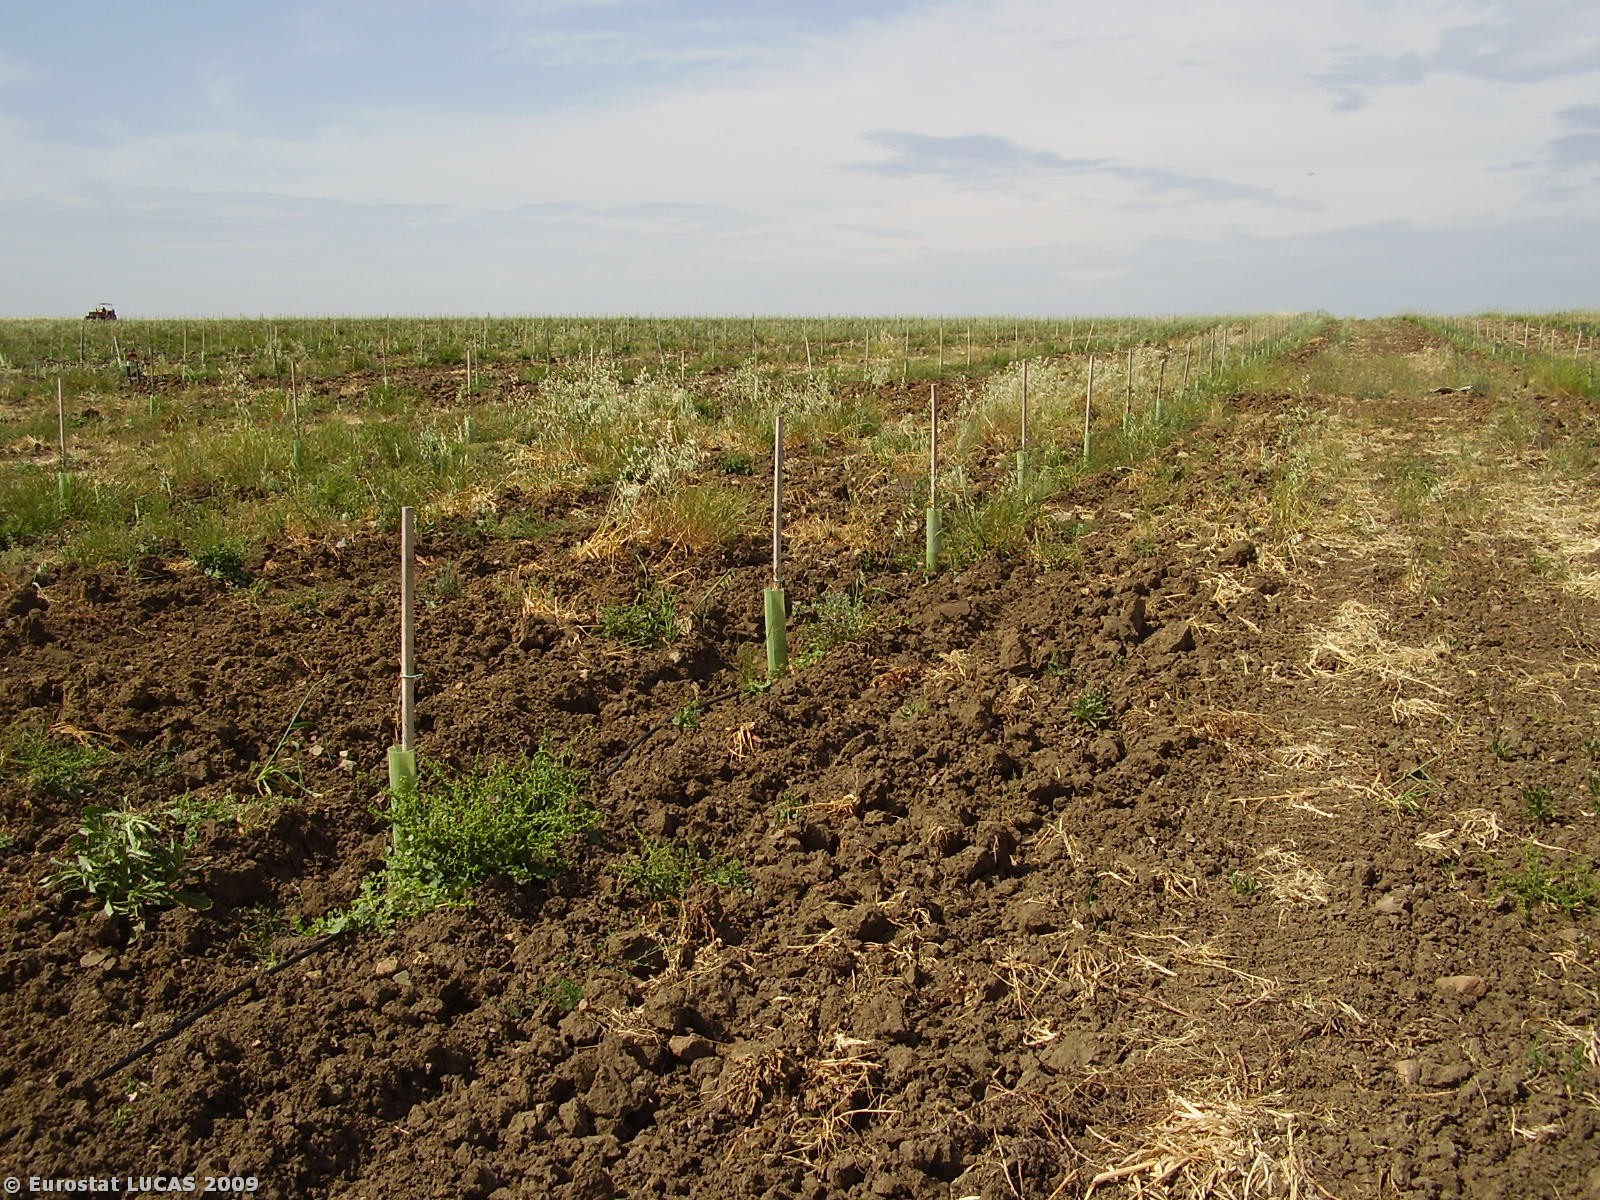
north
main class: Cropland
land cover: Olive groves
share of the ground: 50 - 75 %
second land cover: Bare land
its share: 25 - 50 %
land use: Agriculture (excluding fallow land and kitchen gardens)
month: May
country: PT
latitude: 37.9826
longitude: -7.7746
